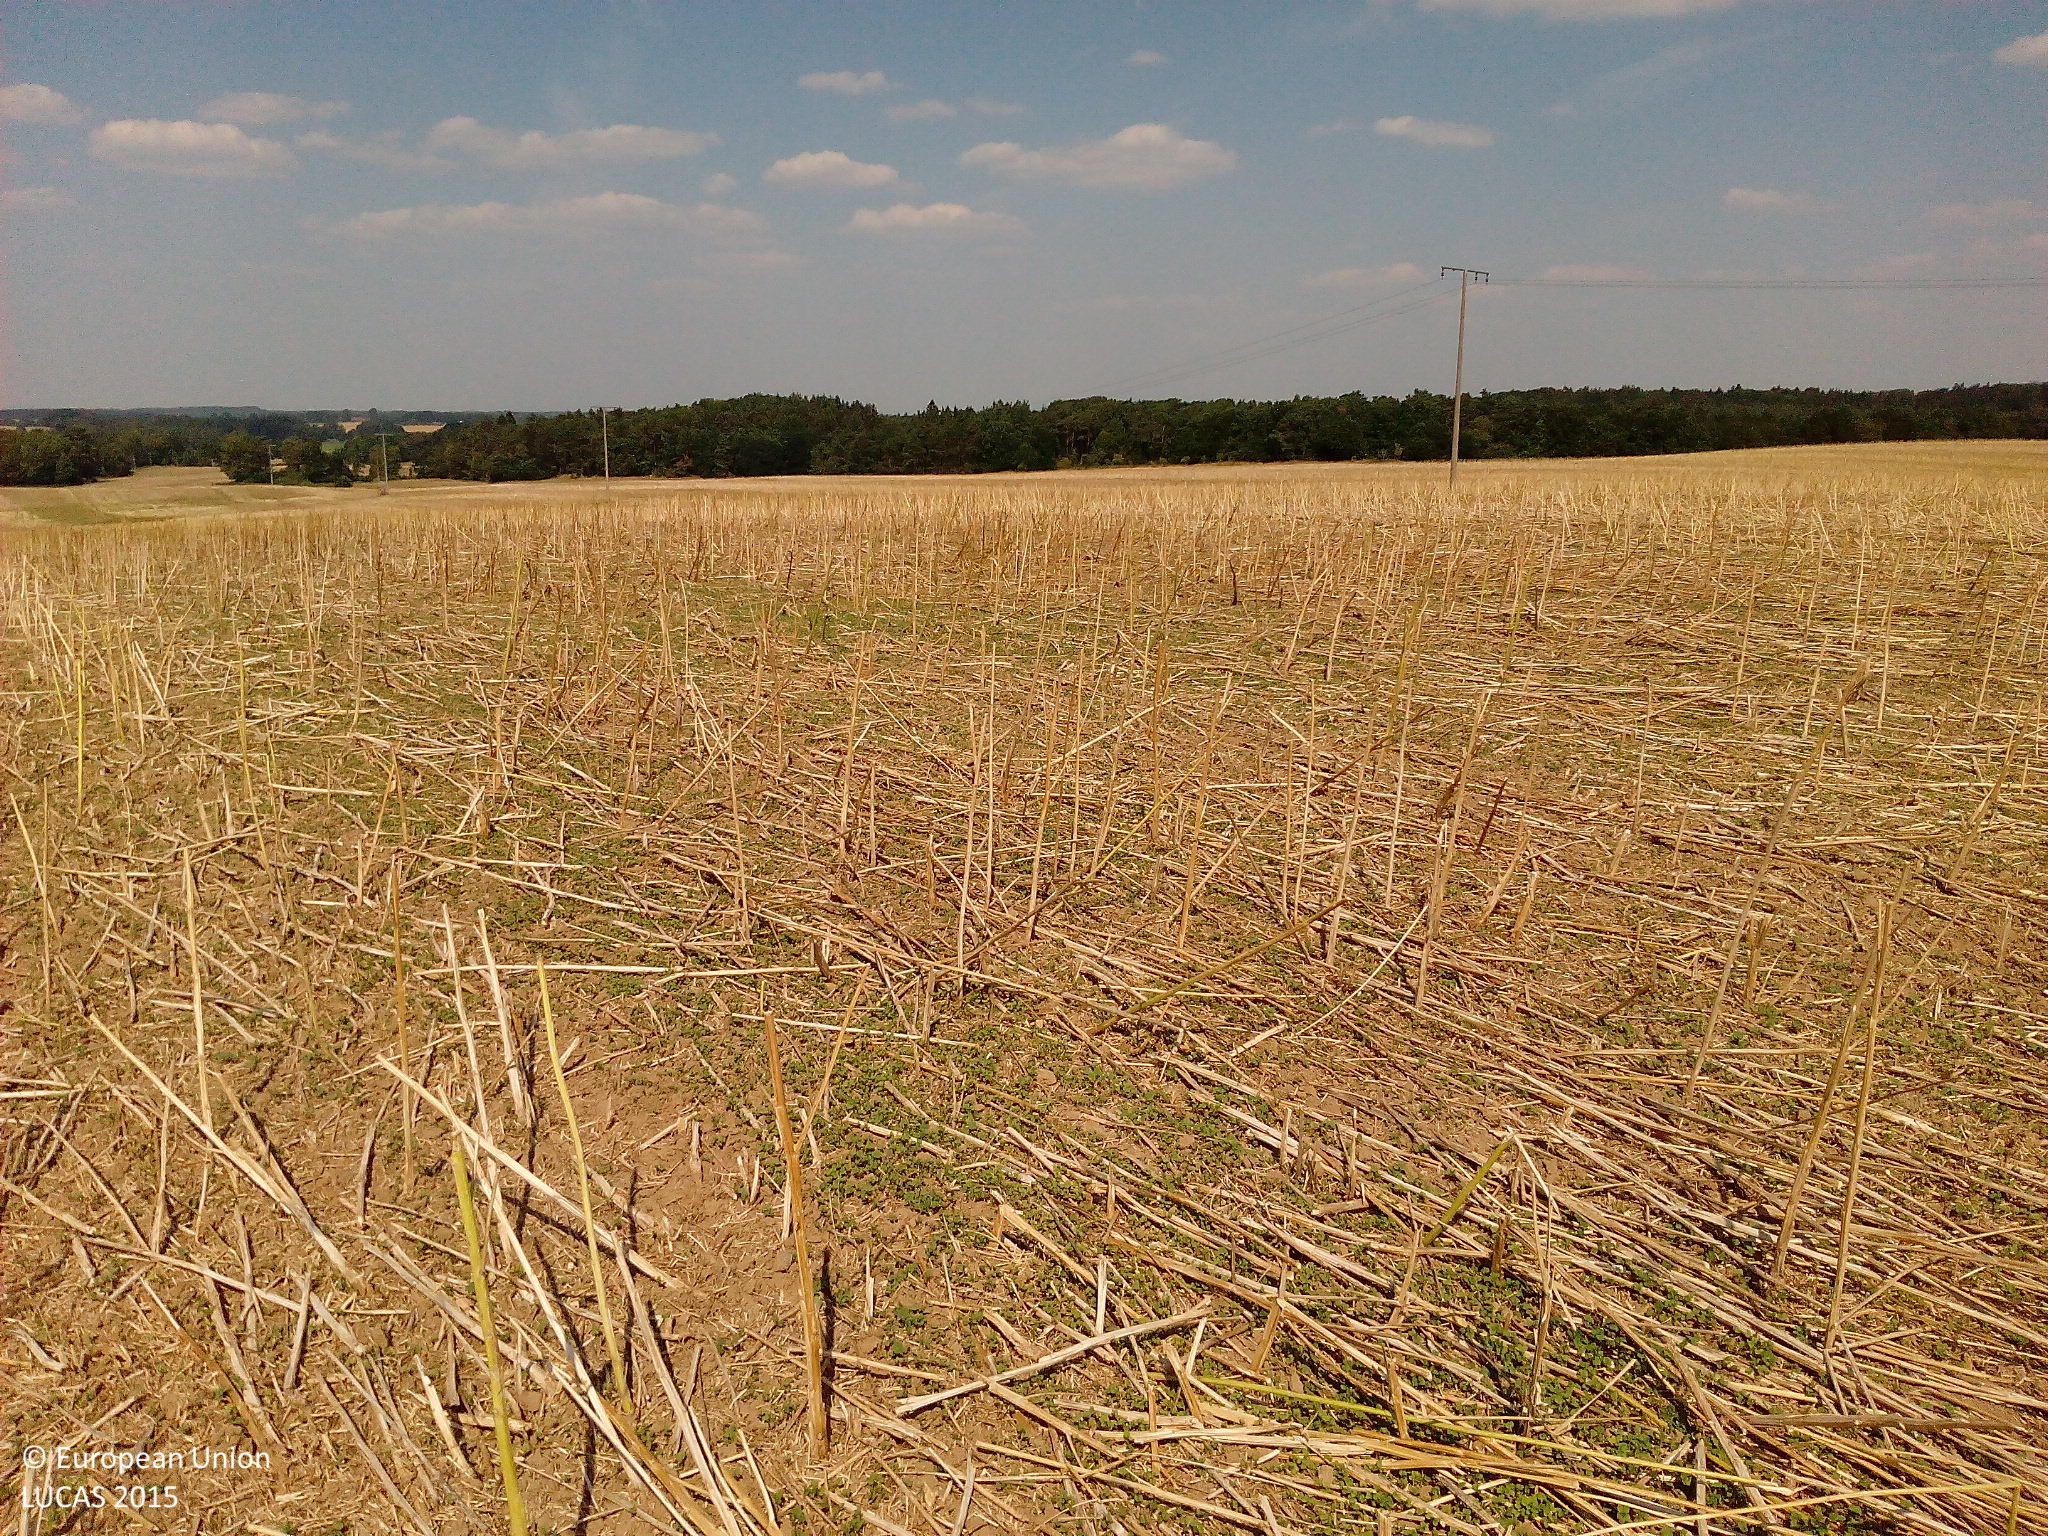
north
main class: Cropland
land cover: Rape and turnip rape
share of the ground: < 10 %
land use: Agriculture (excluding fallow land and kitchen gardens)
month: August
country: DE
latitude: 53.9884
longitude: 12.4546
